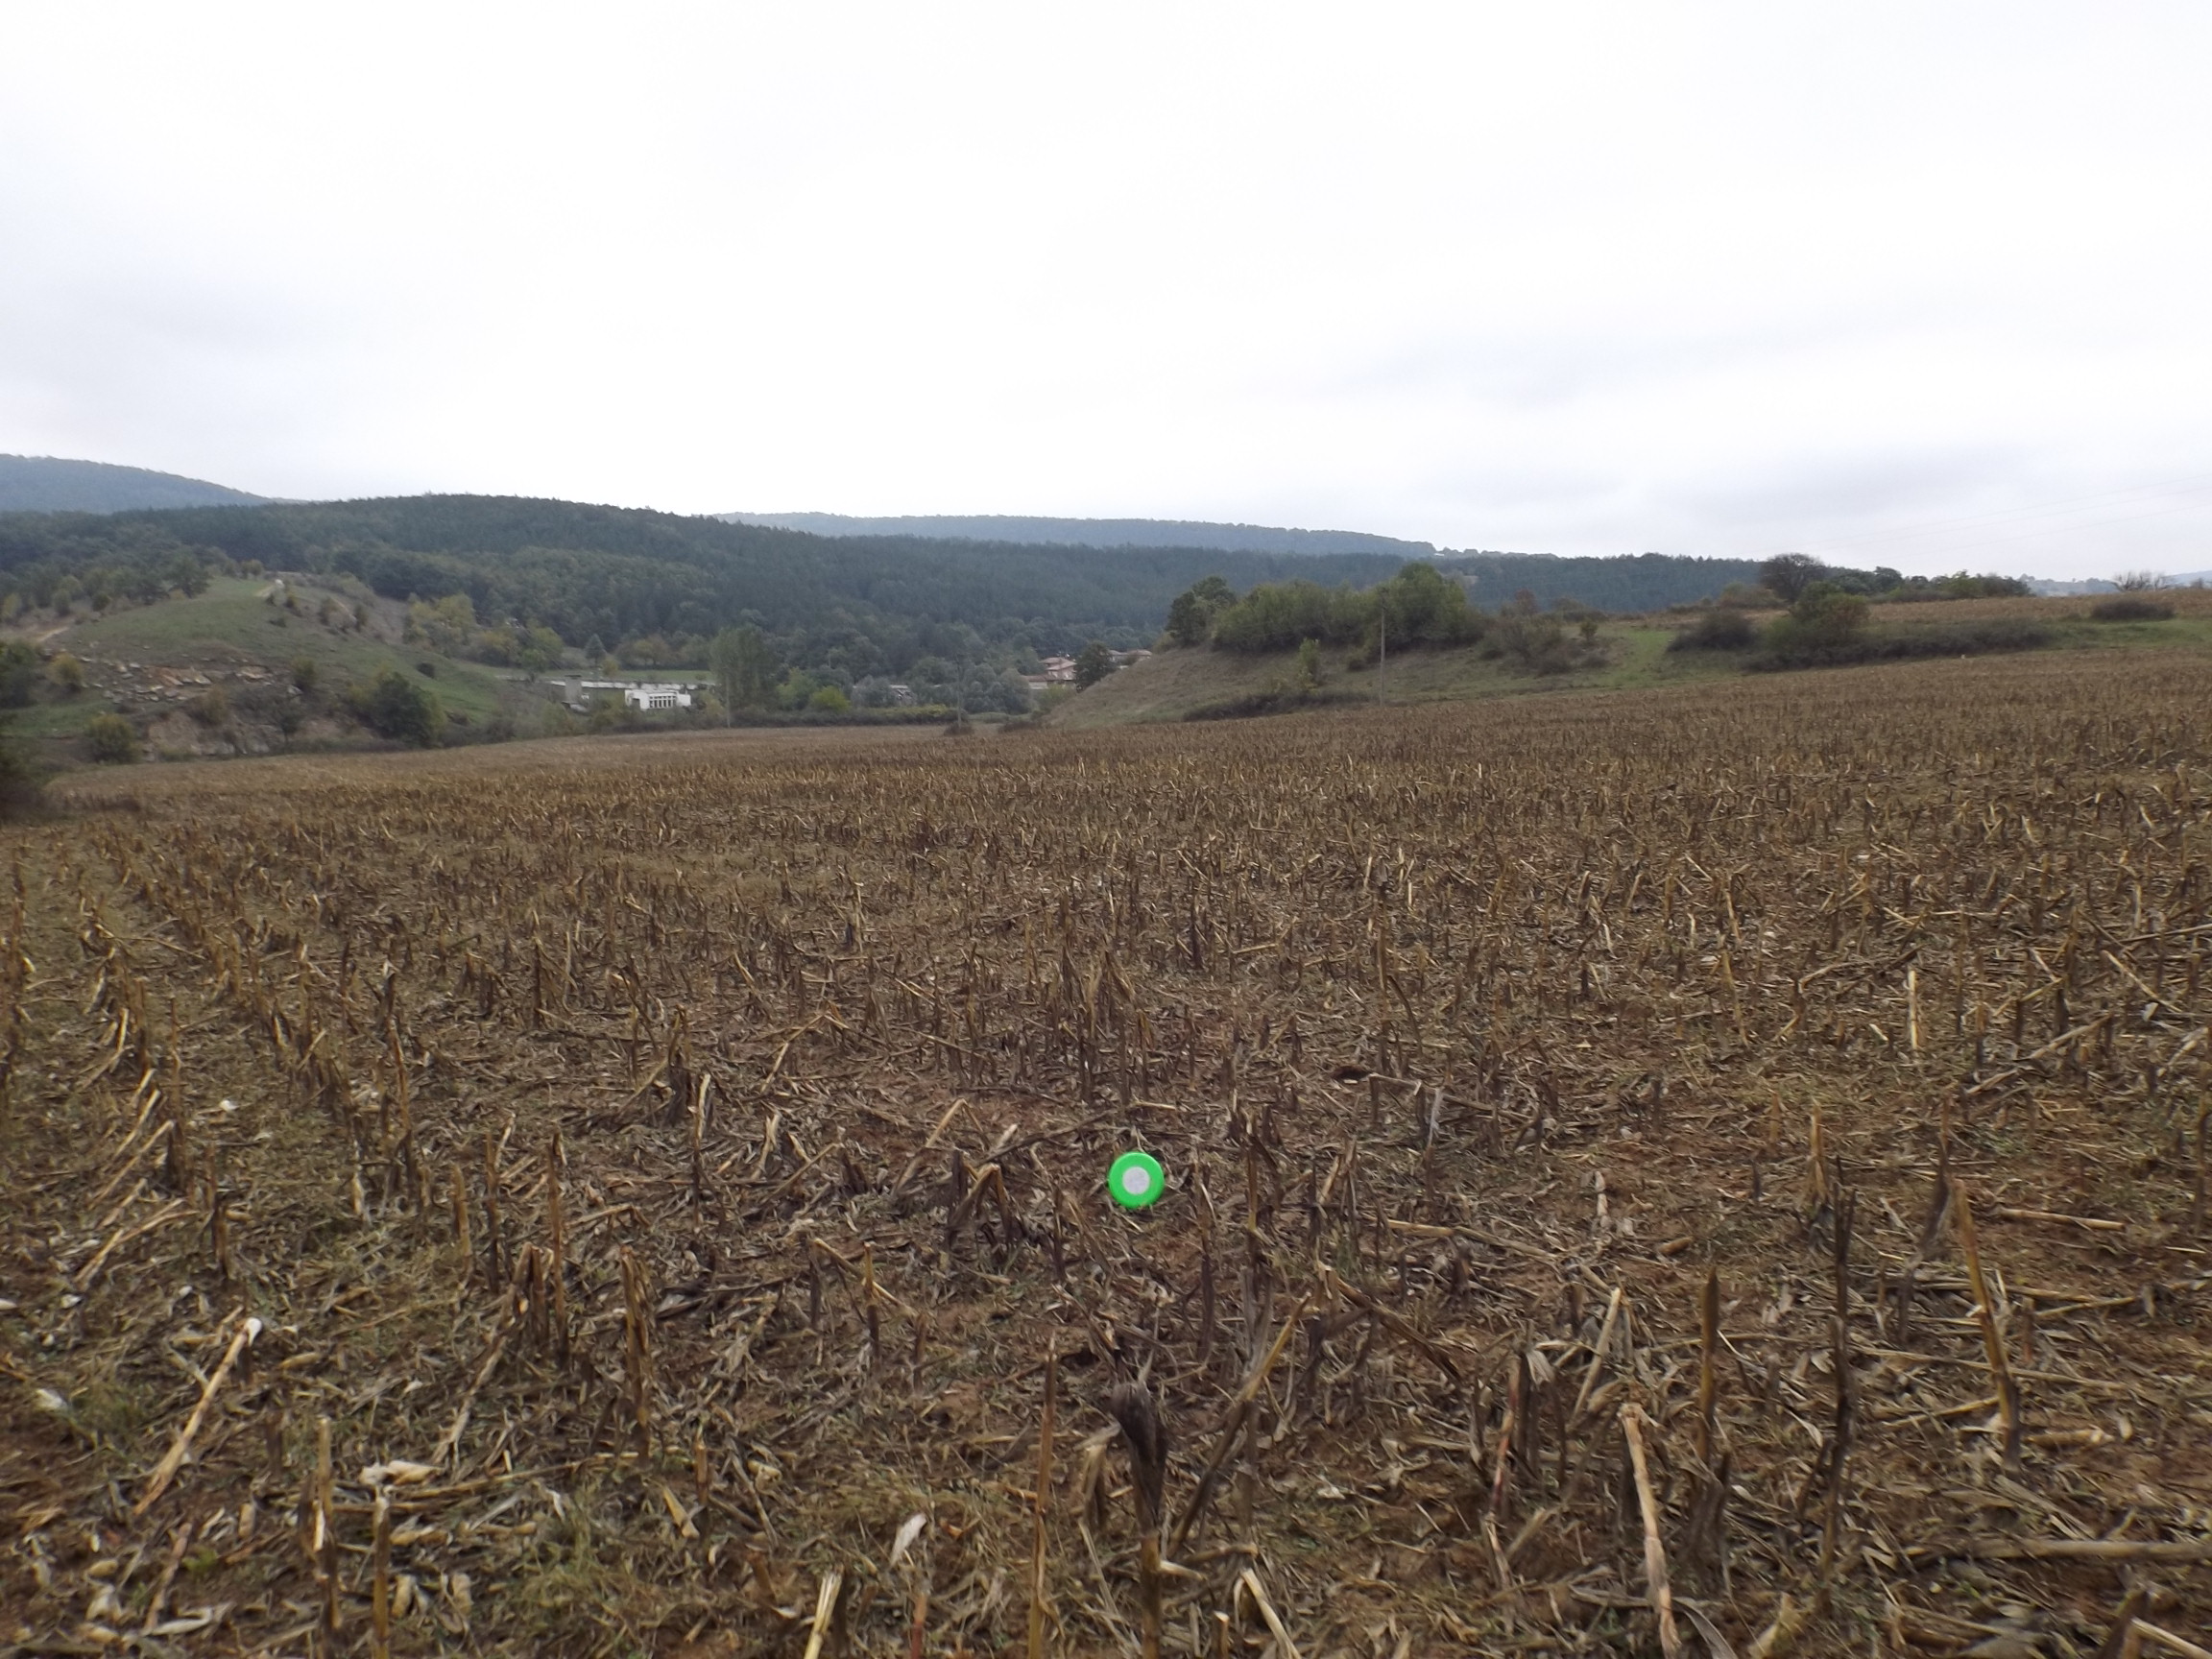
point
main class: Cropland
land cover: Maize
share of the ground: 10 - 25 %
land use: Agriculture (excluding fallow land and kitchen gardens)
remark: Harvested field
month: October
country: BG
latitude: 42.9969
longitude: 27.1780
